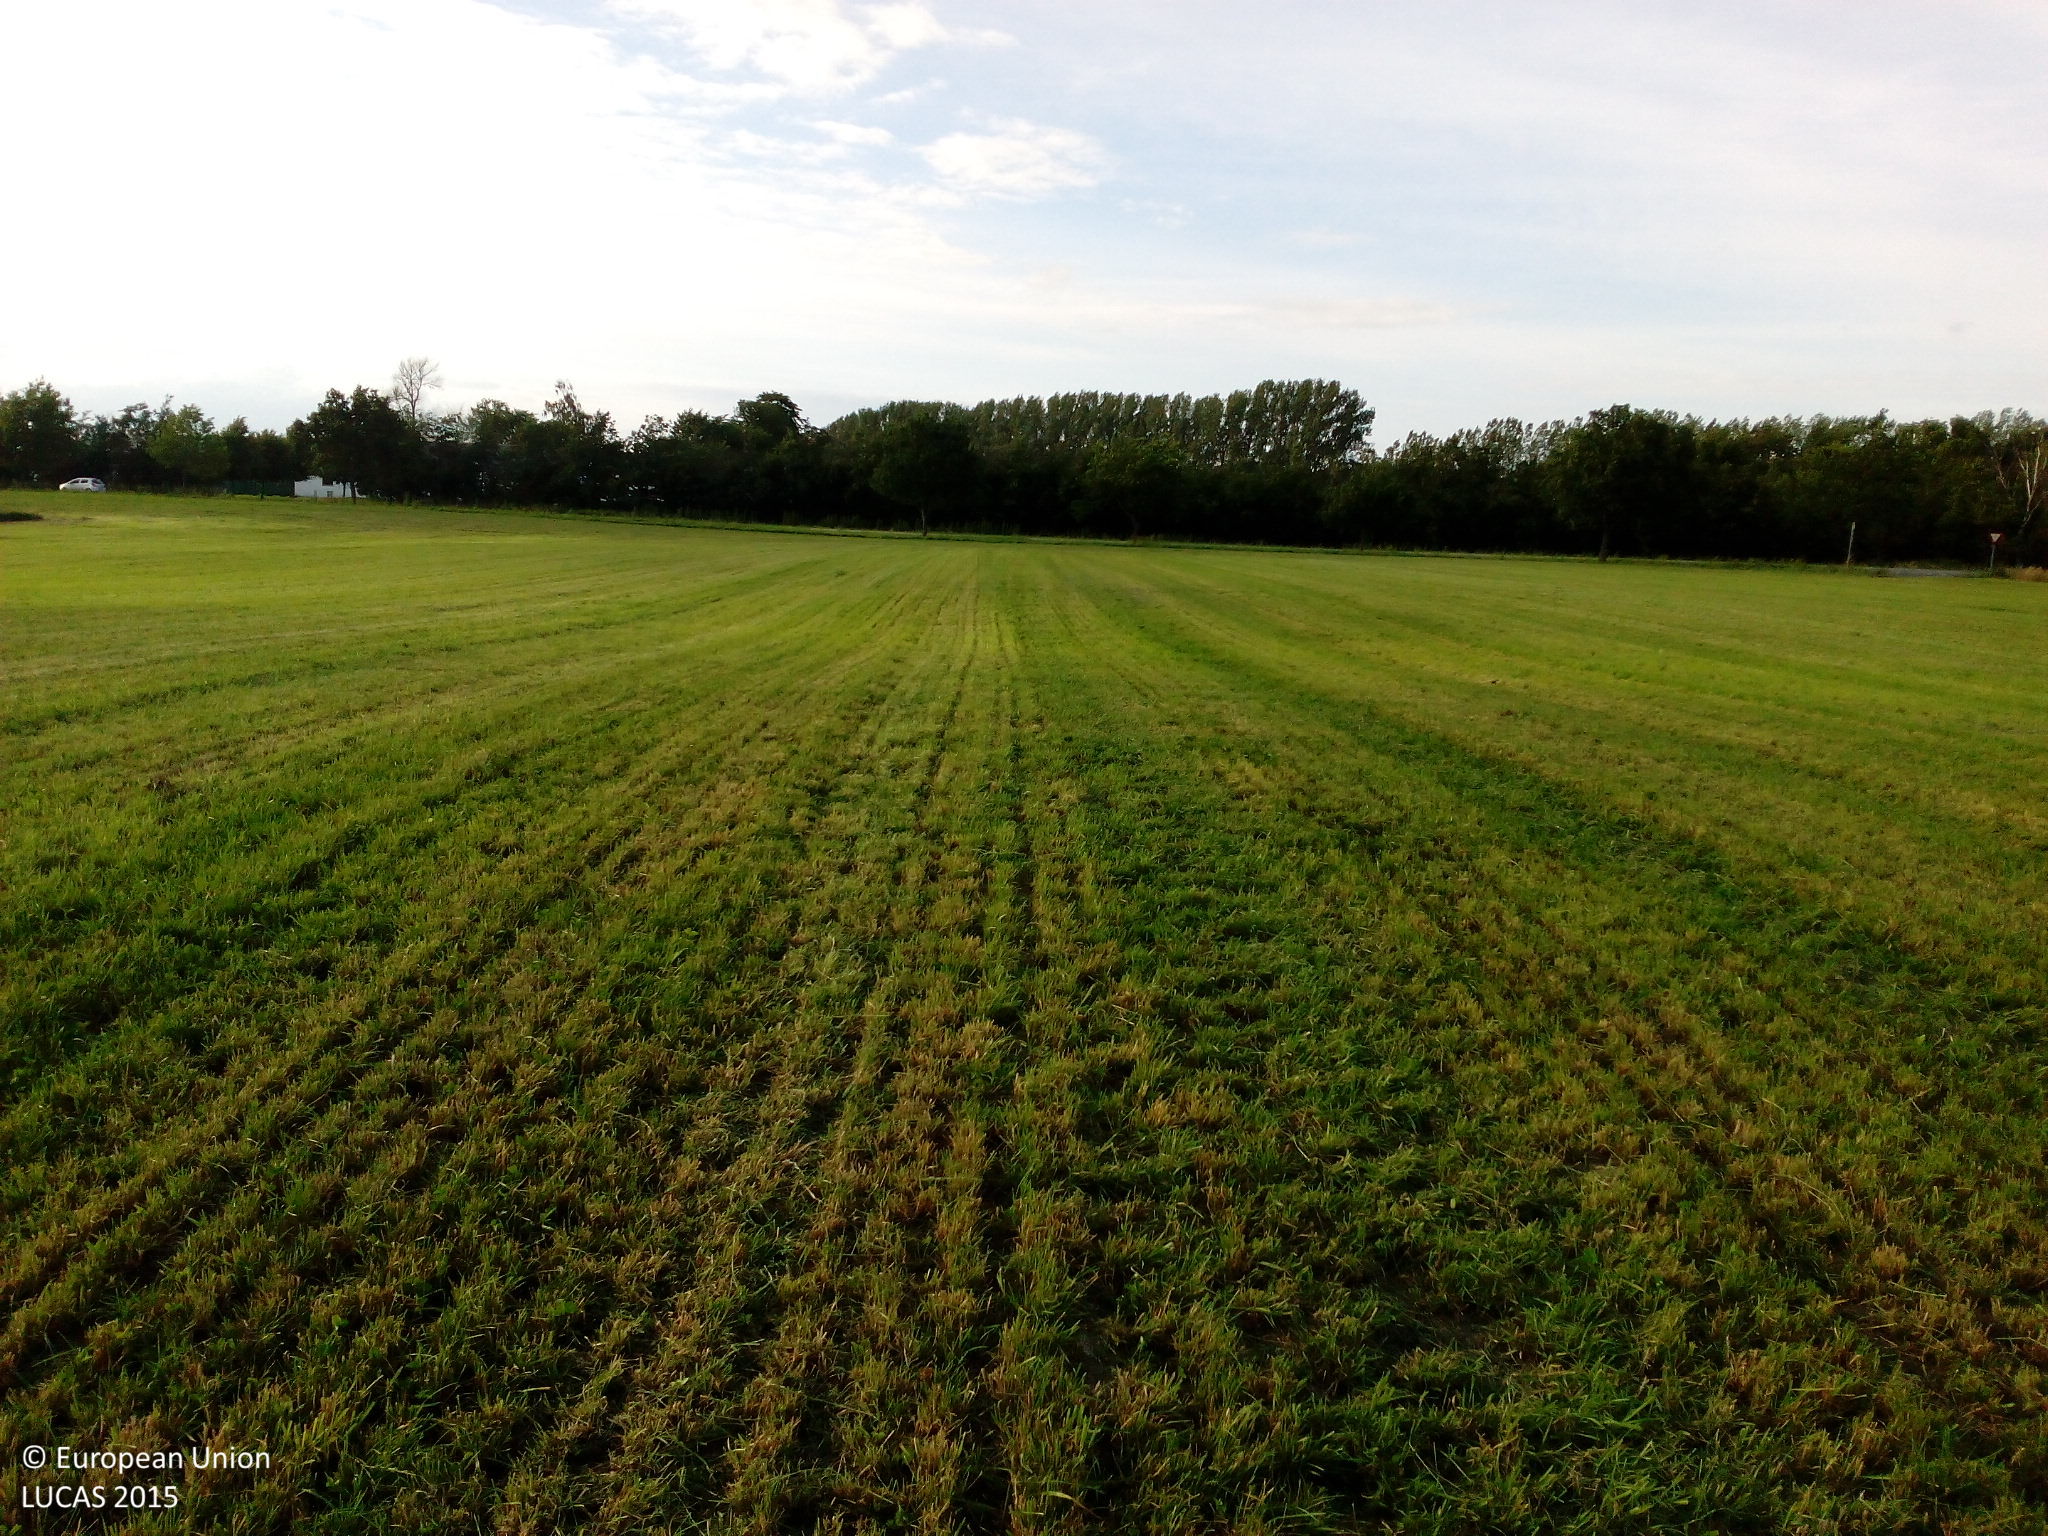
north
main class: Grassland
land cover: Grassland without tree/shrub cover
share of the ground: > 75 %
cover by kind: herbaceous plants 100 %
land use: Agriculture (excluding fallow land and kitchen gardens)
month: July
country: DK
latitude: 55.9358
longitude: 12.1591
